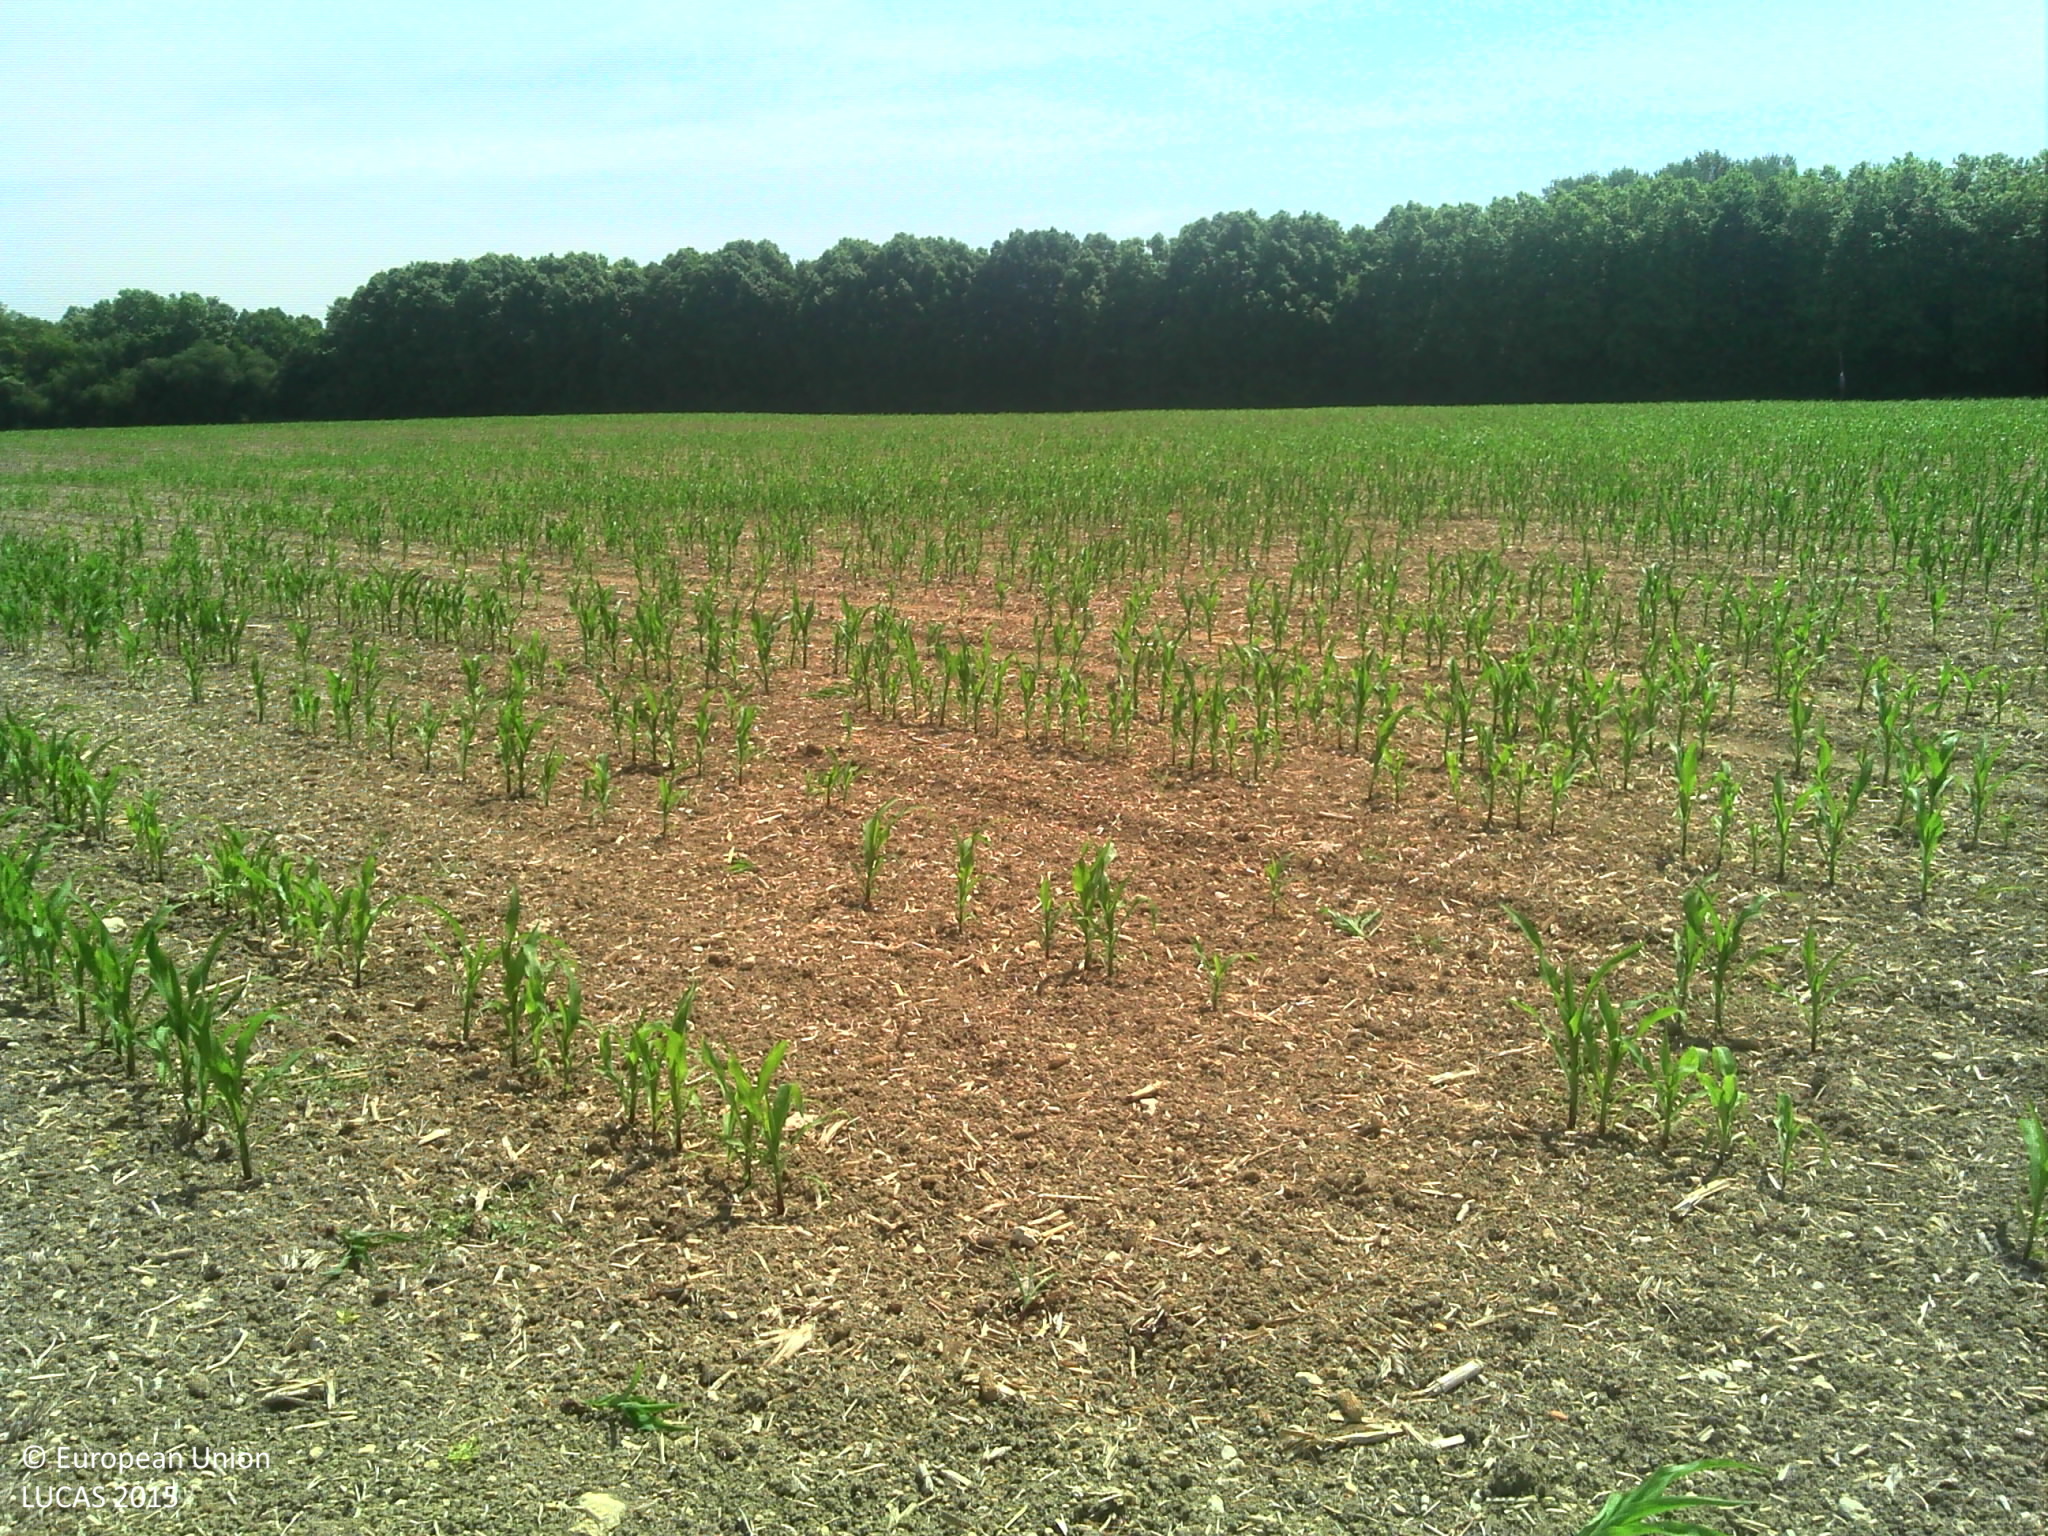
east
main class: Cropland
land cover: Maize
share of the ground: 10 - 25 %
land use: Agriculture (excluding fallow land and kitchen gardens)
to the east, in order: Maize; Broadleaved woodland
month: June
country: FR
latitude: 47.4866
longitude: 1.3719
